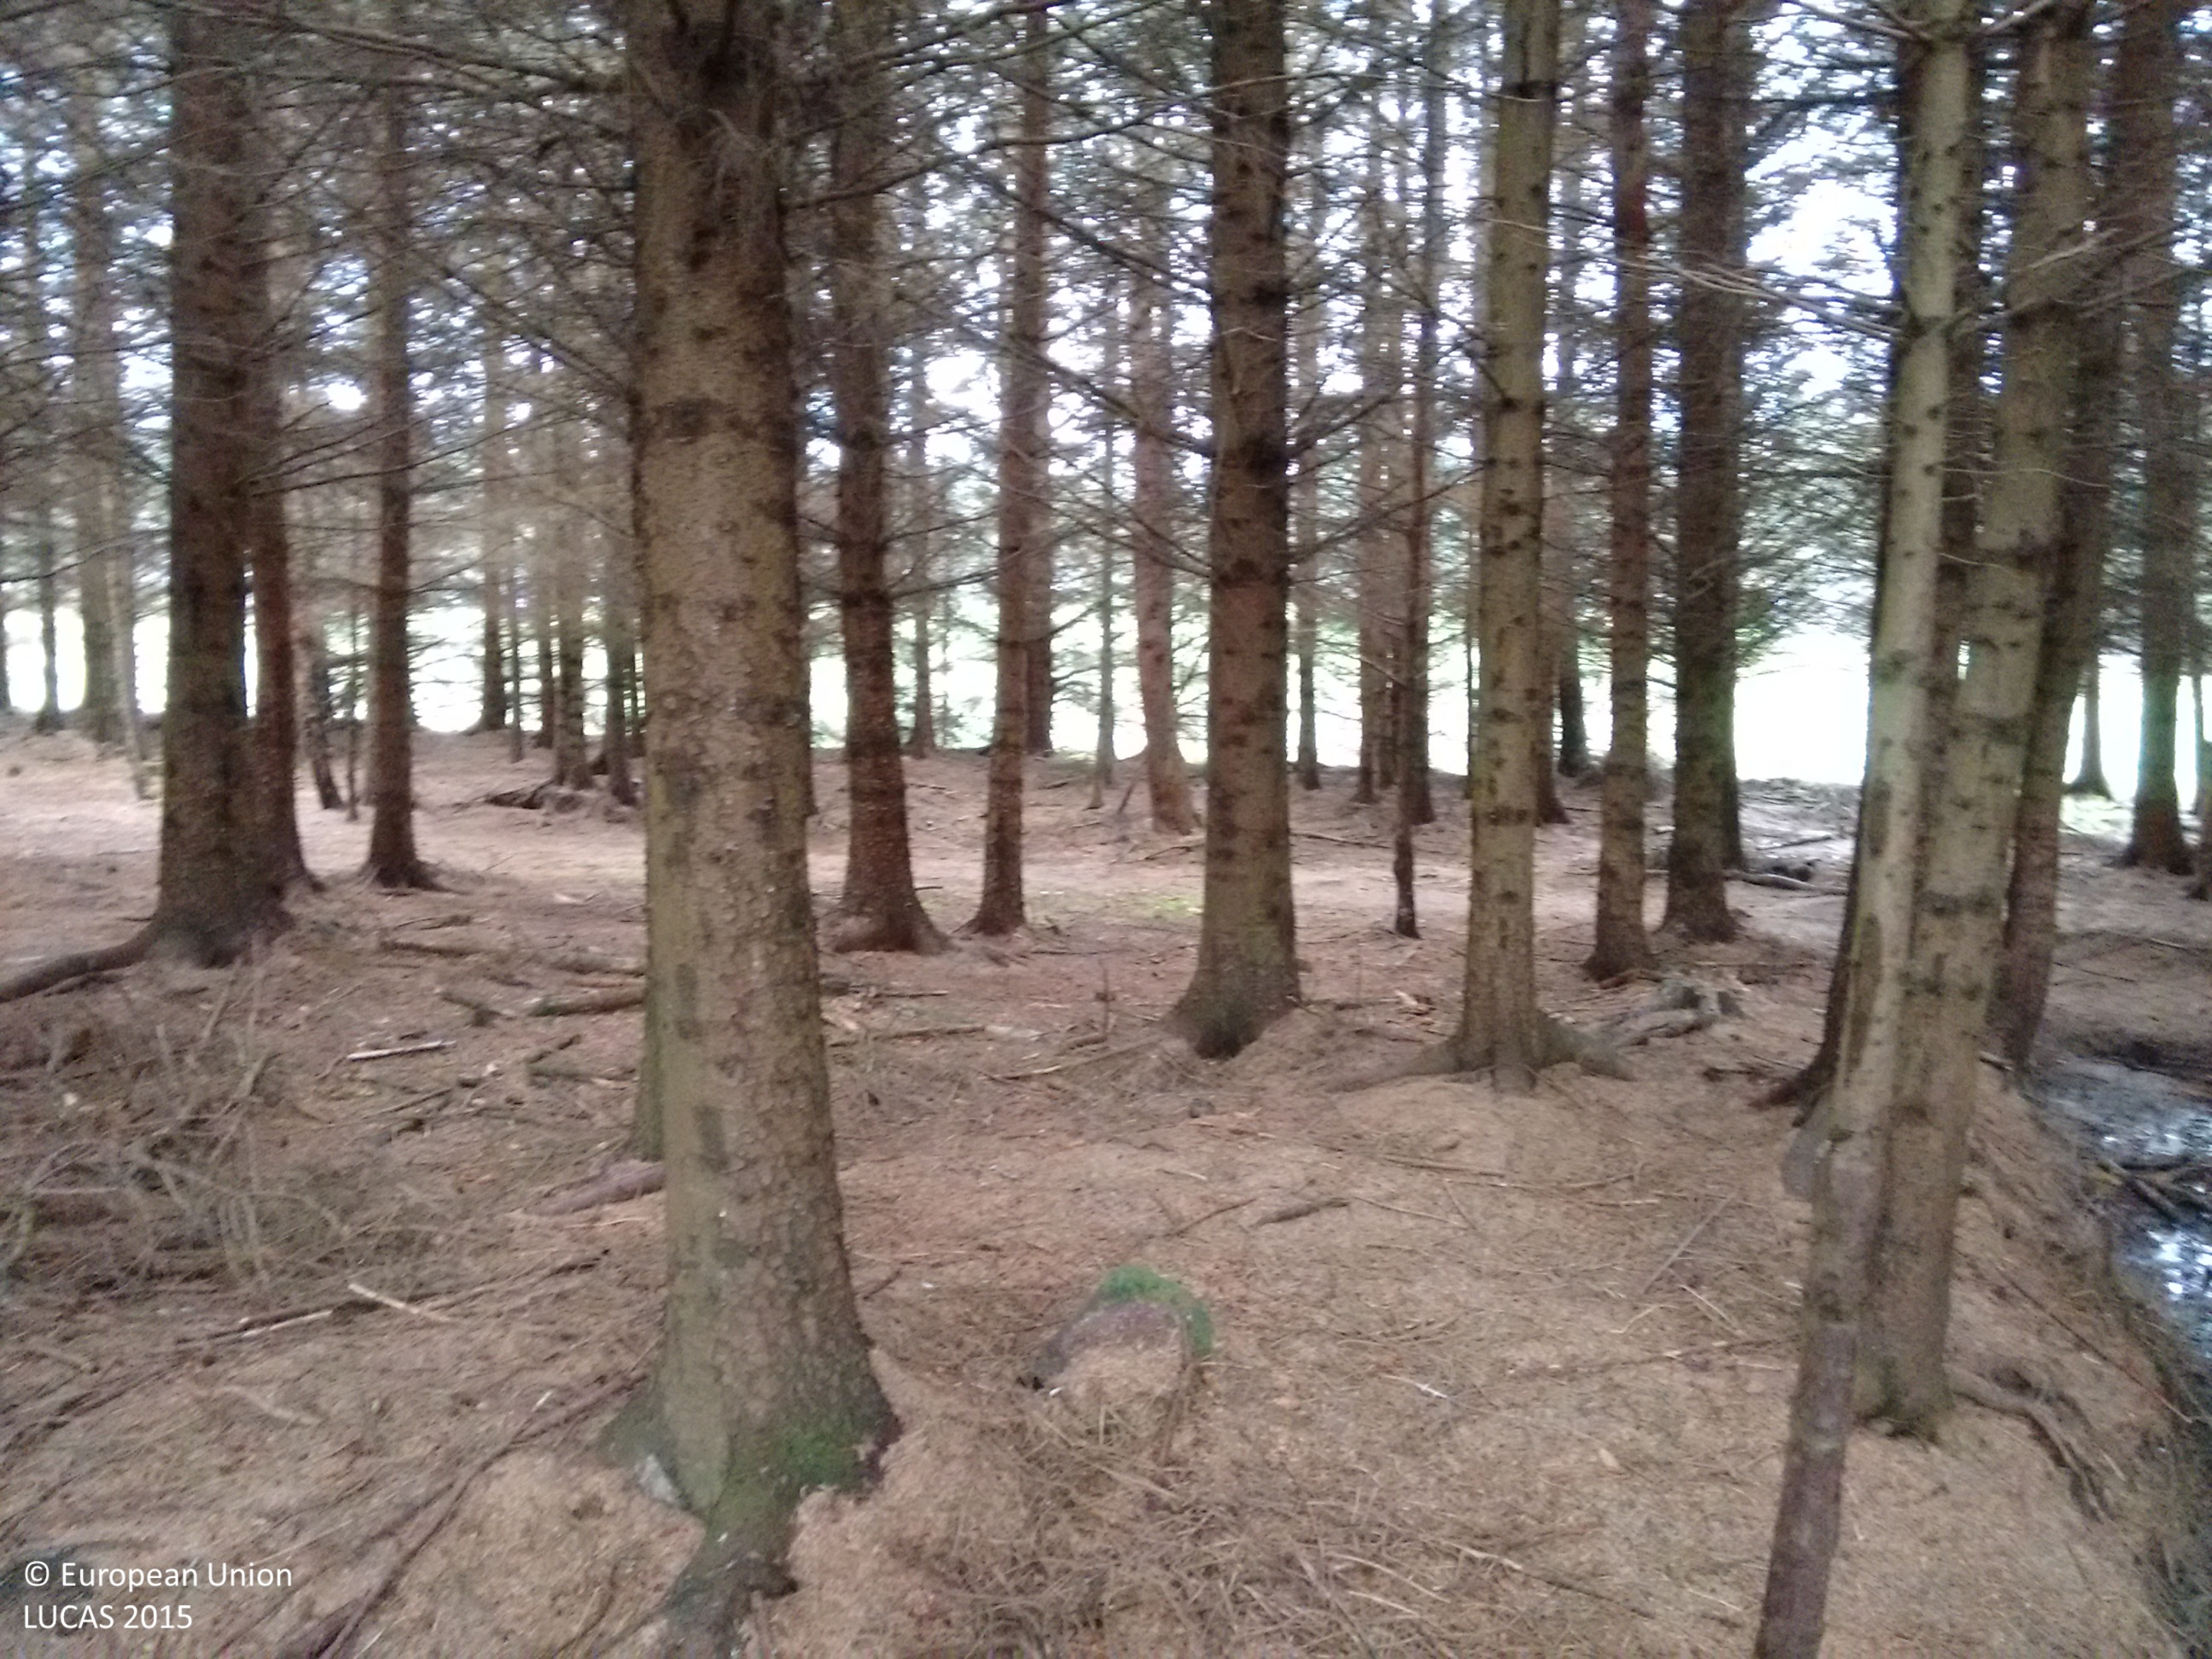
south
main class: Woodland
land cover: Spruce dominated coniferous woodland
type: exotic forest
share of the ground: > 75 %
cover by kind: coniferous forest trees 95 %, unconsolidated bare surface 5 %
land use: Forestry
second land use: Amenities, museums, leisure
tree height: > 5 m
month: May
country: GB
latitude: 55.8259
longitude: -3.2424
